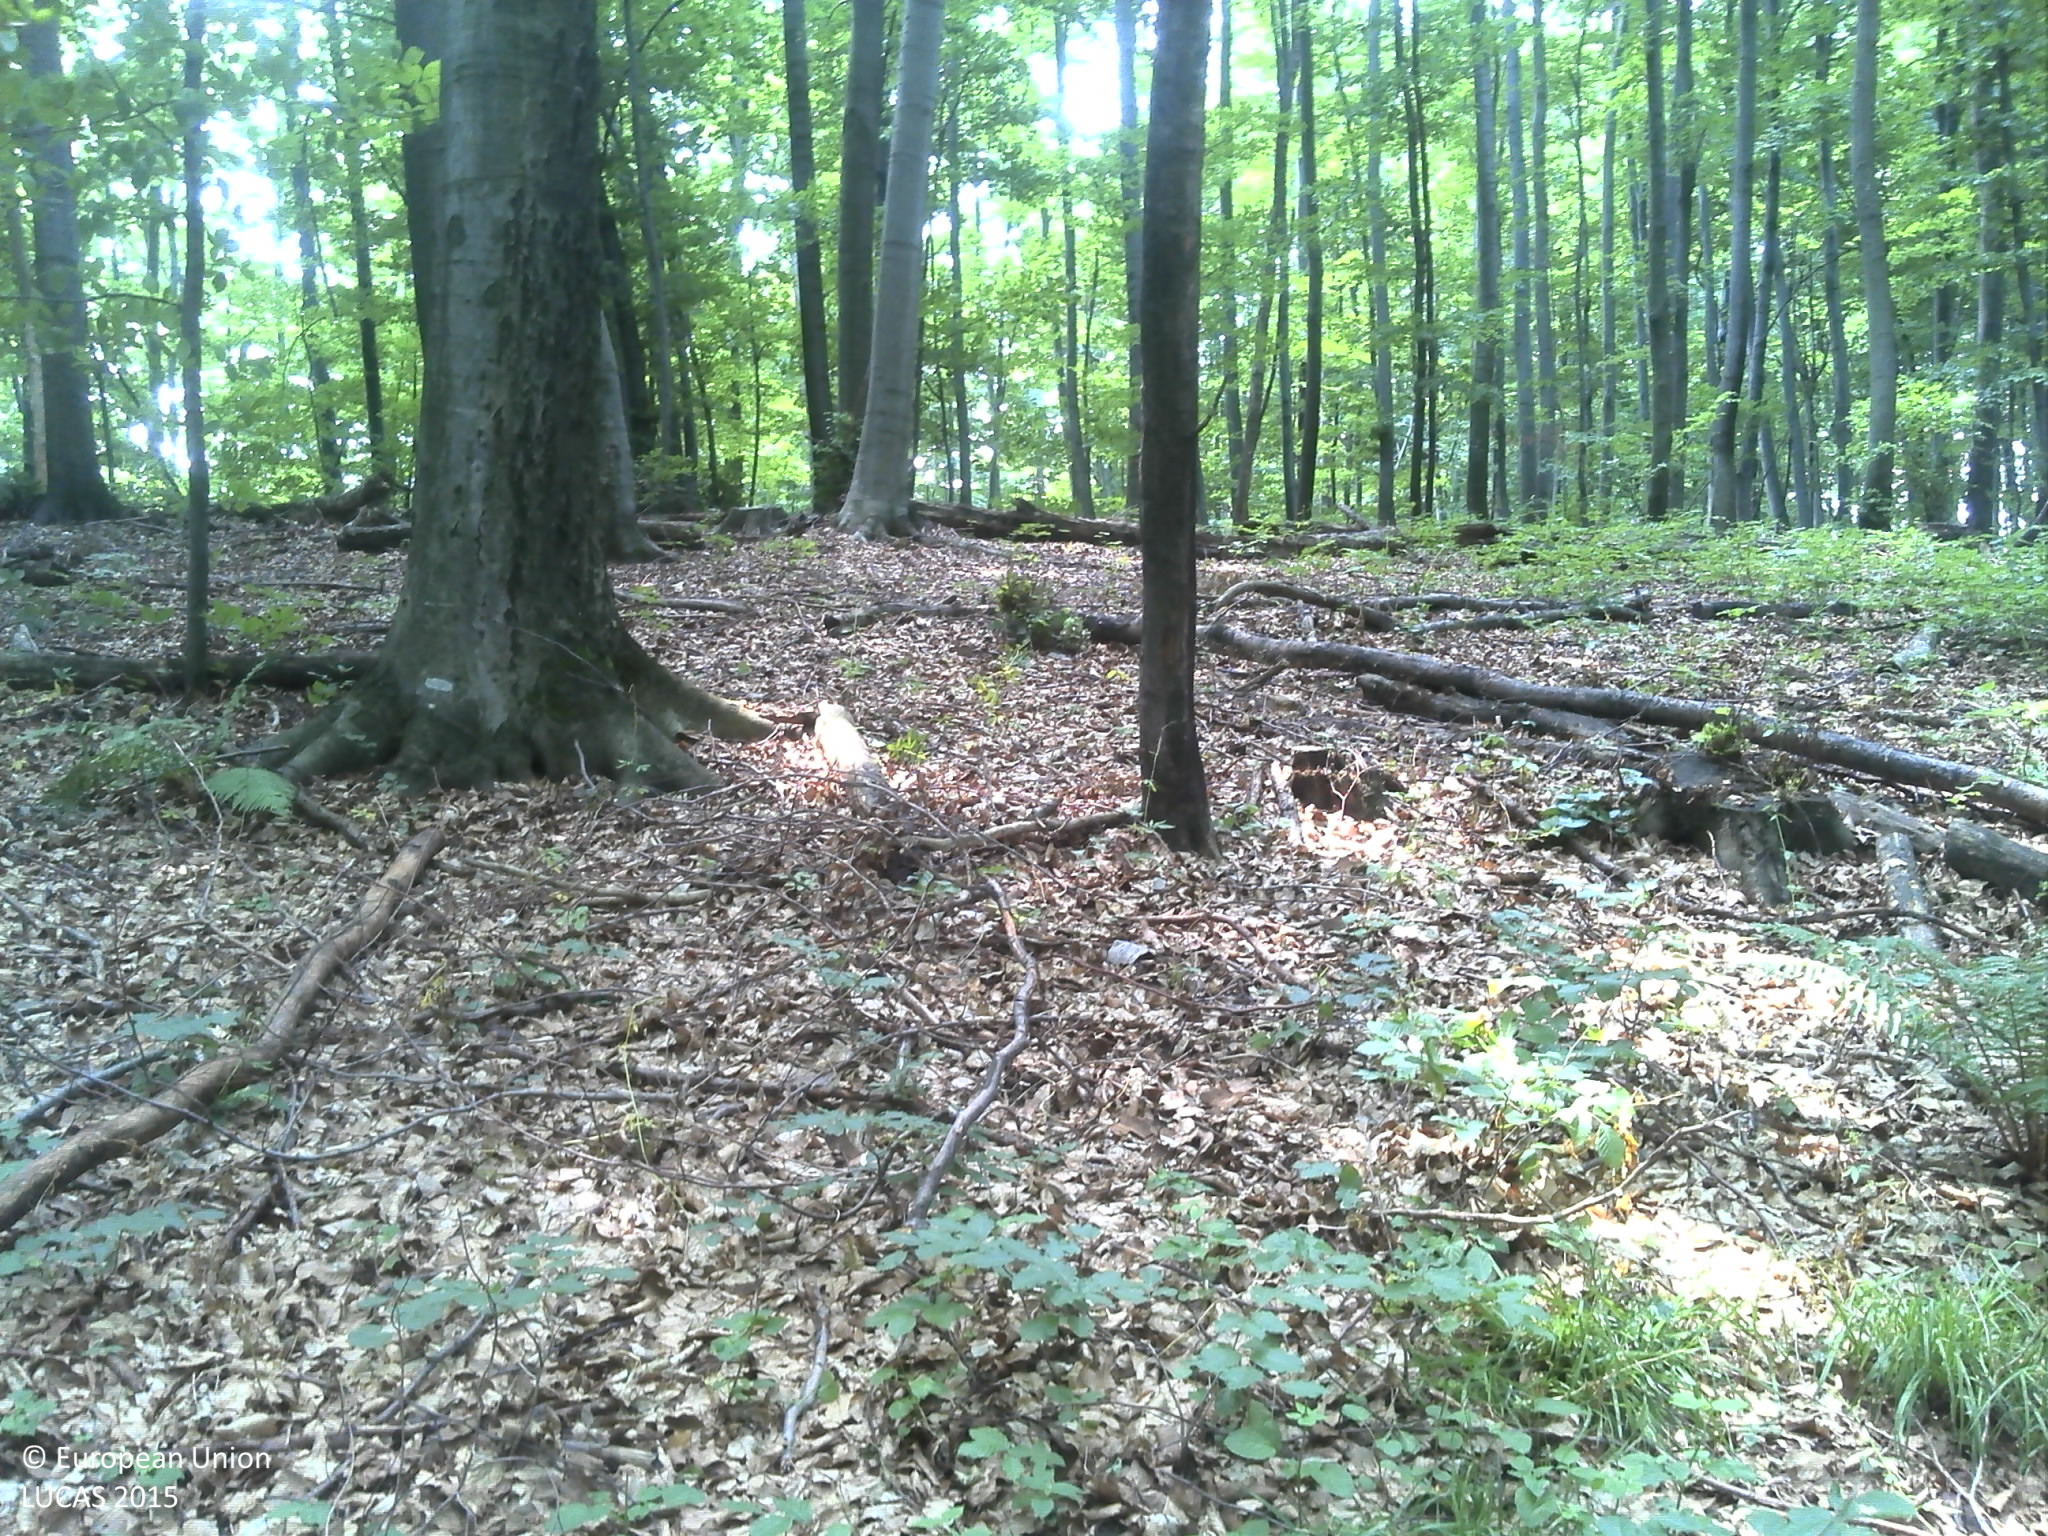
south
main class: Woodland
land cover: Broadleaved woodland
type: beech forest
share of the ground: > 75 %
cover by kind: broadleaved forest trees 90 %, shrubs 5 %, herbaceous plants 5 %
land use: Forestry
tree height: > 5 m
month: June
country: HR
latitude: 45.6171
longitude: 17.5041
